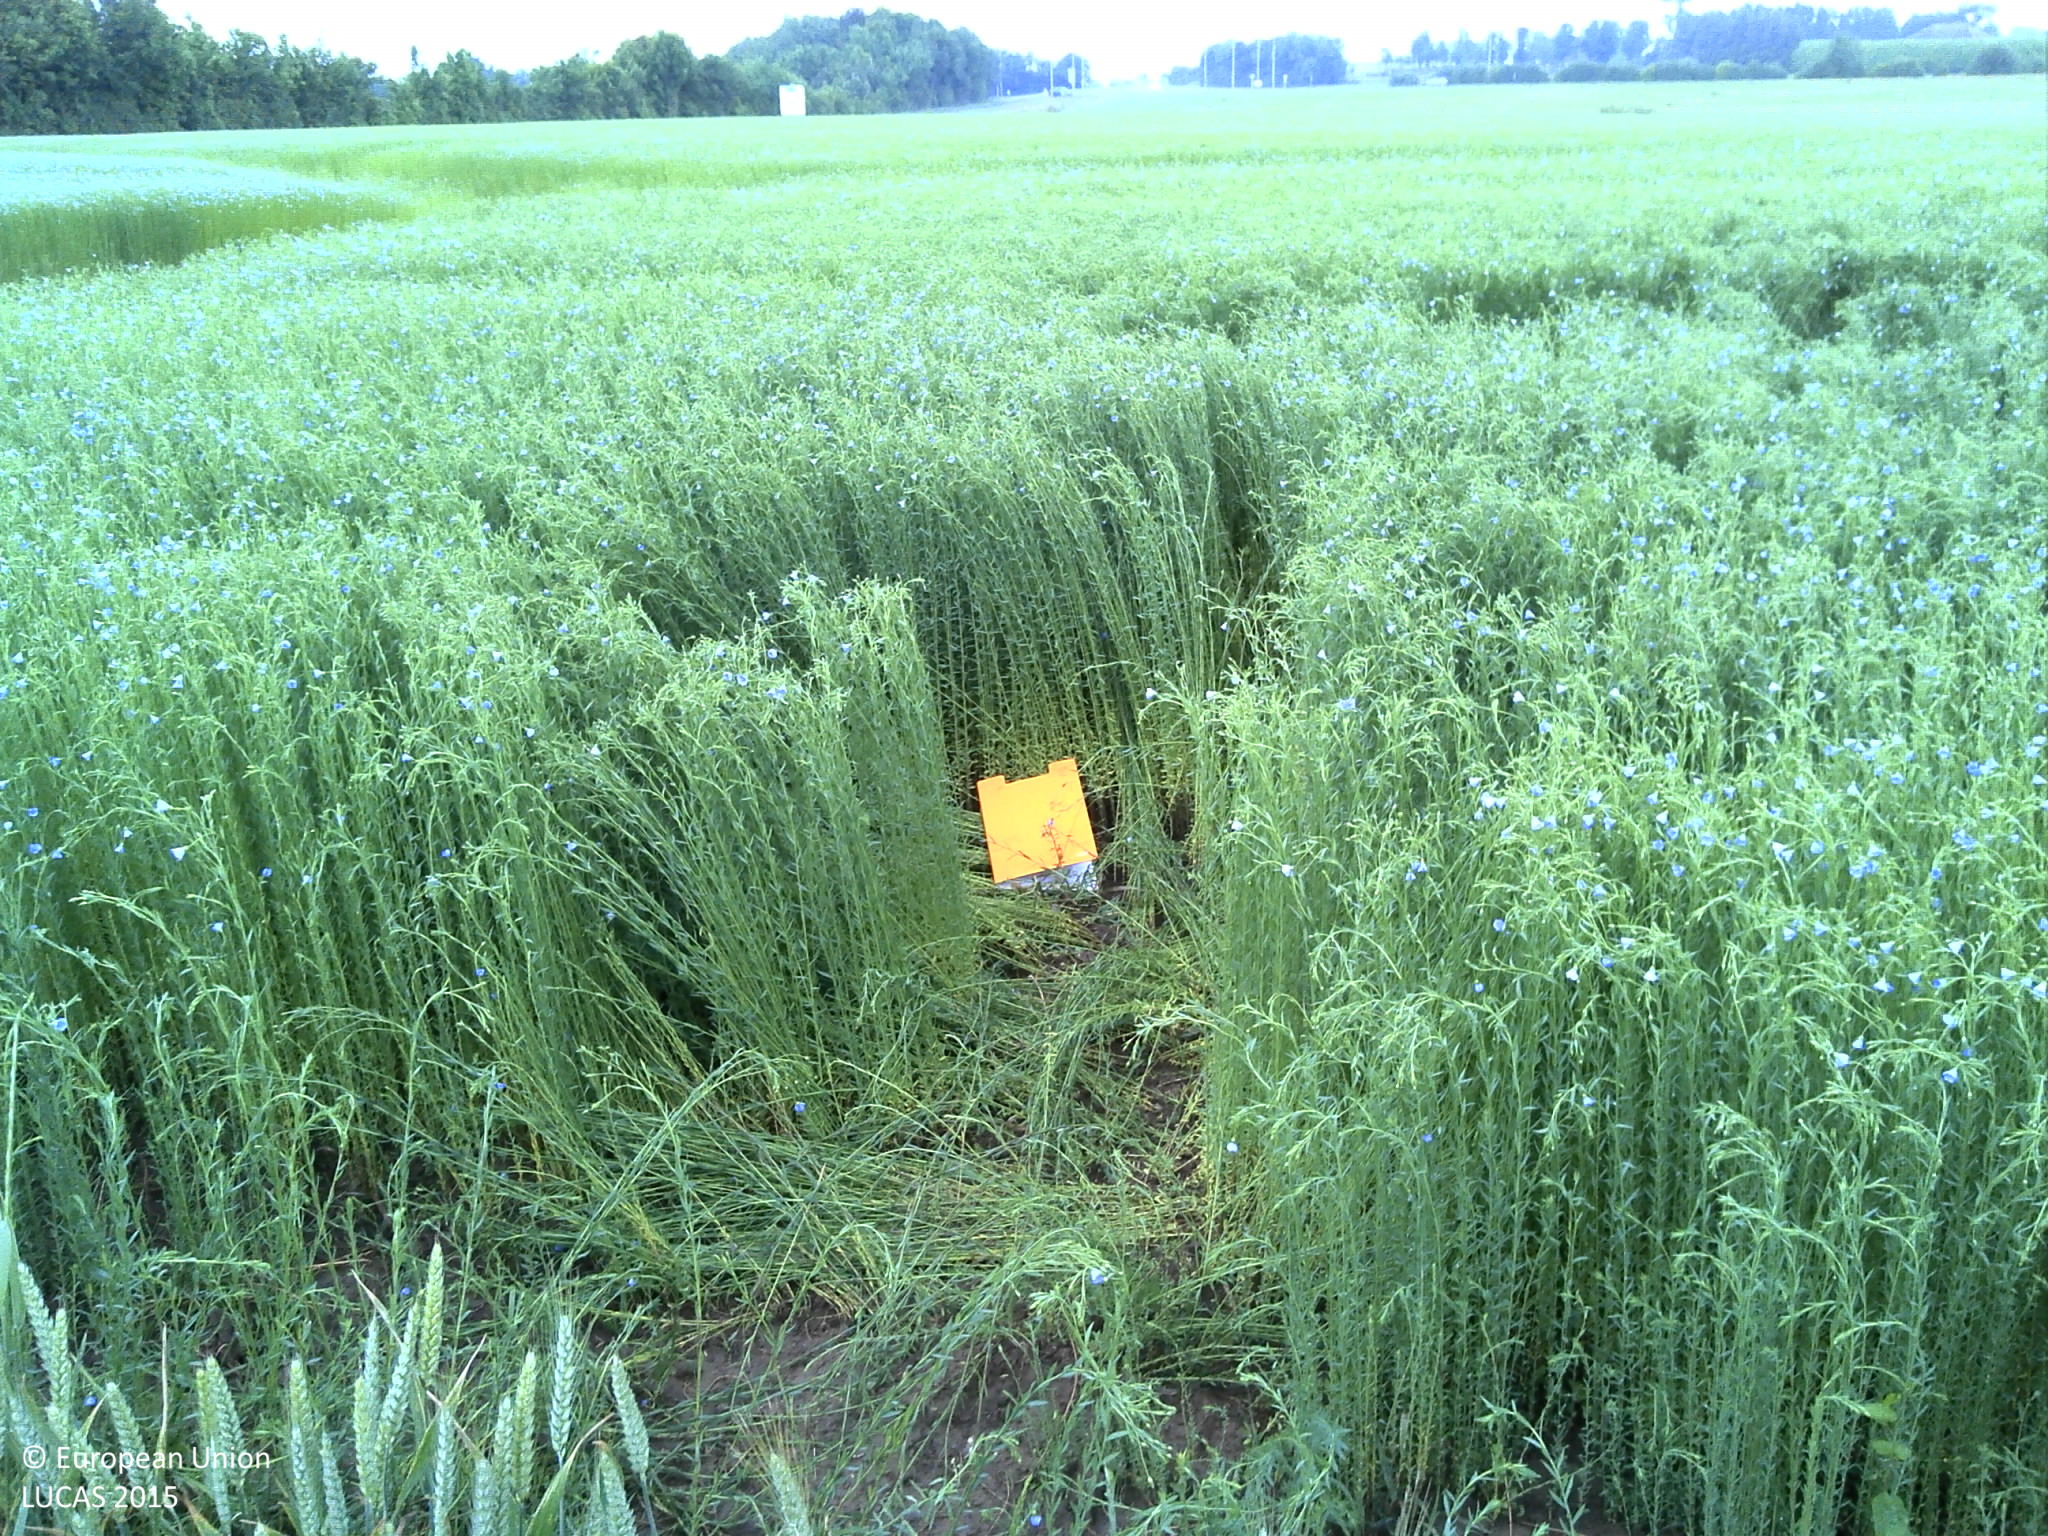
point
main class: Cropland
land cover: Other fibre and oleaginous crops
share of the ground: > 75 %
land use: Agriculture (excluding fallow land and kitchen gardens)
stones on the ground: < 10 %
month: June
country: FR
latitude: 49.5377
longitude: 0.3402
